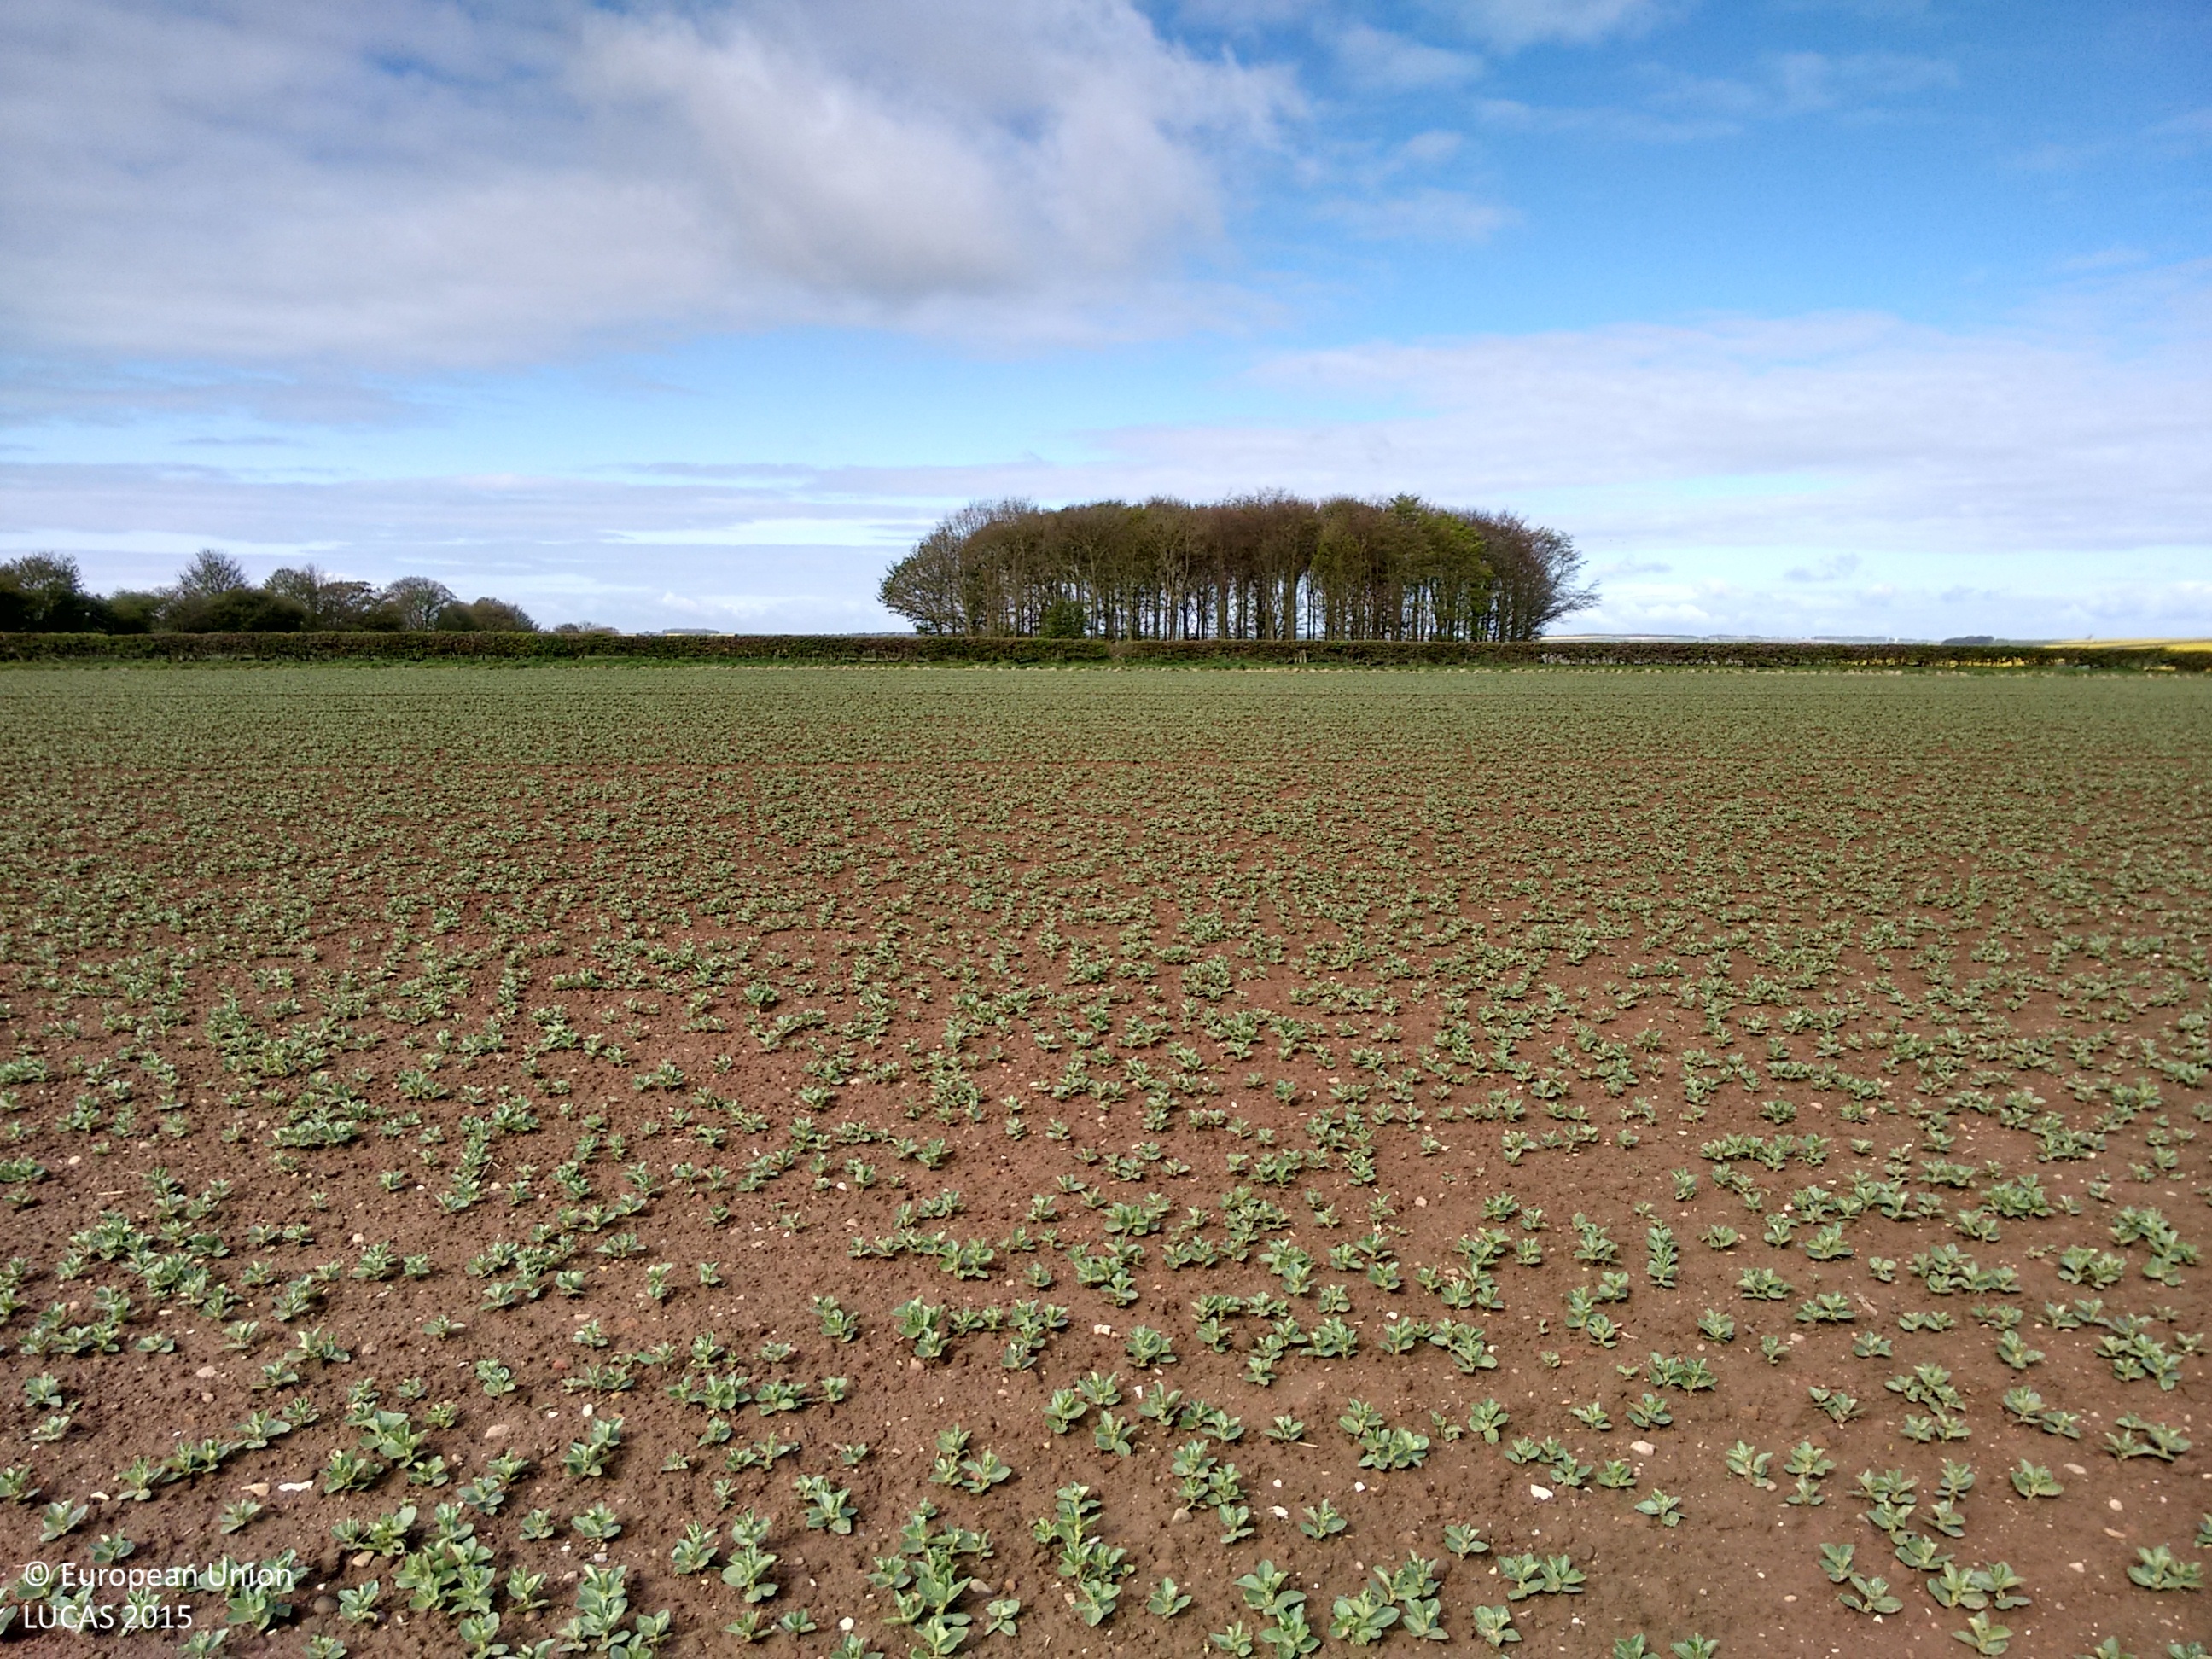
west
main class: Cropland
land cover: Dry pulses
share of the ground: 10 - 25 %
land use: Agriculture (excluding fallow land and kitchen gardens)
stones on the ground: < 10 %
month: May
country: GB
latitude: 54.0635
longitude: -0.3480
